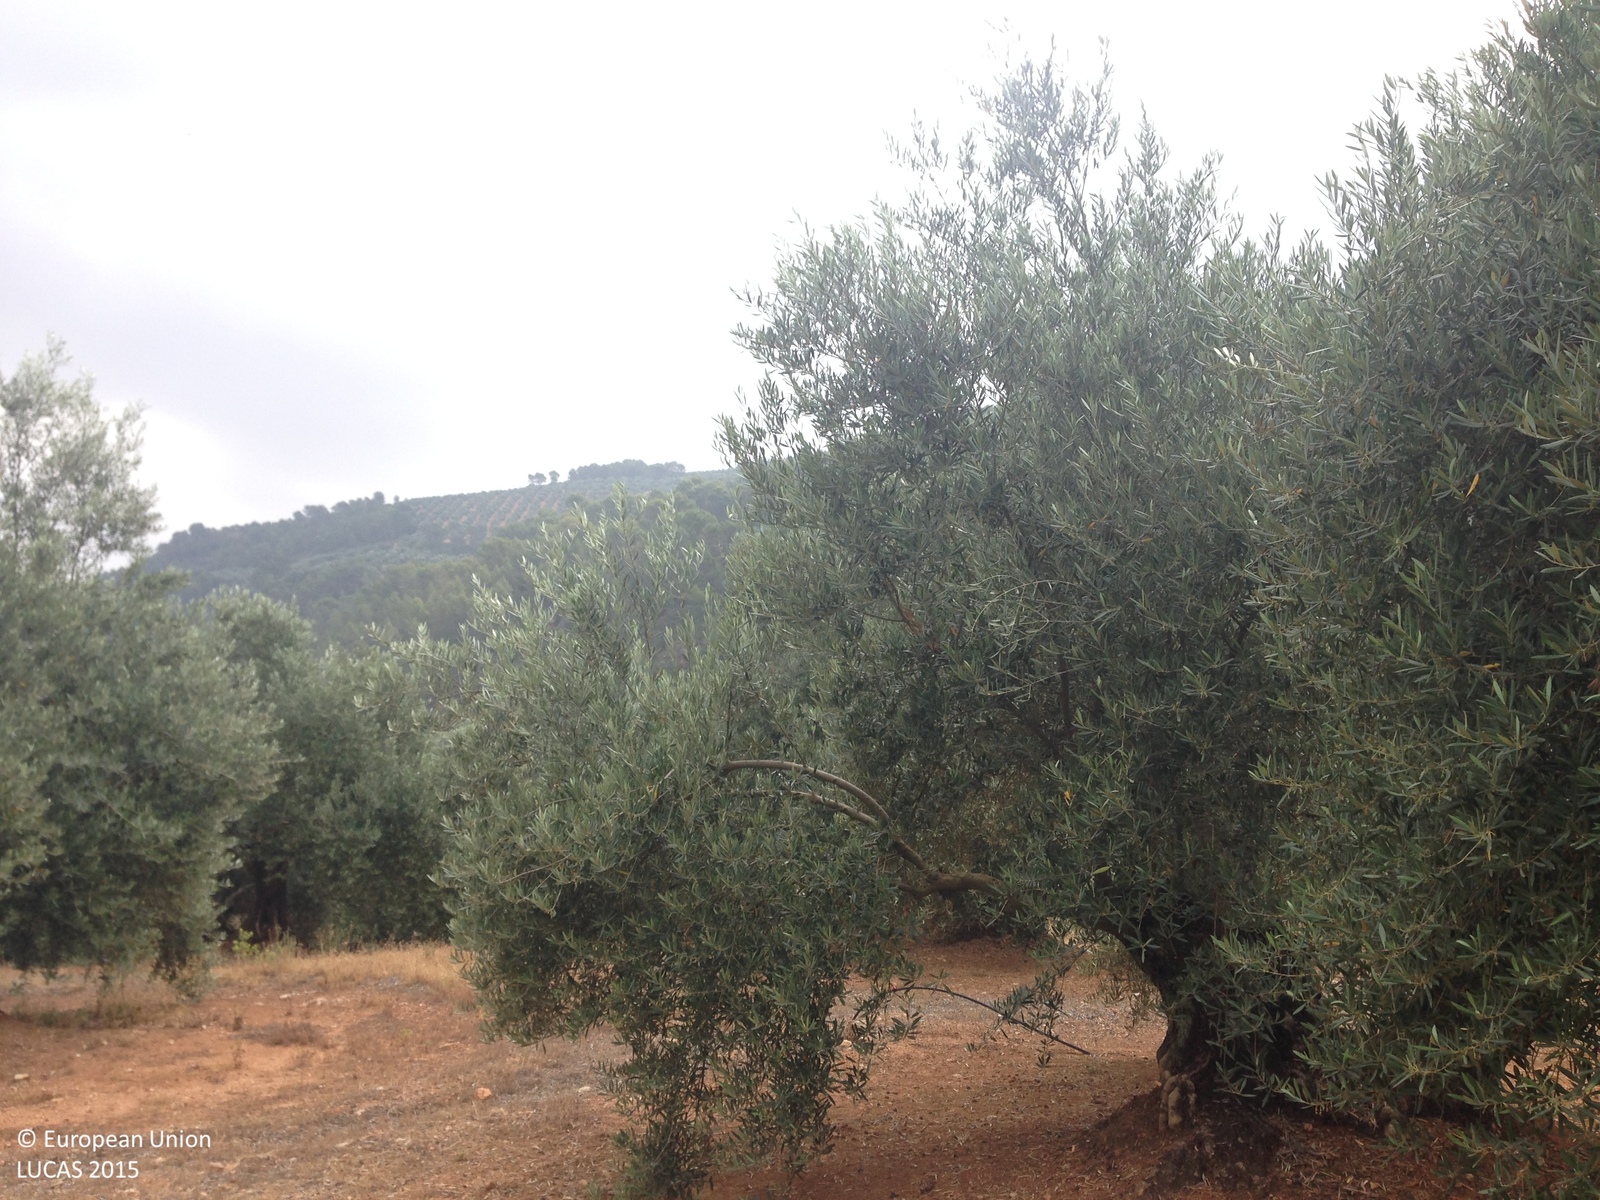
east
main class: Cropland
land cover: Olive groves
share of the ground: 25 - 50 %
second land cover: Other bare soil
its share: > 75 %
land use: Agriculture (excluding fallow land and kitchen gardens)
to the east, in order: Olive groves; Other bare soil; Tracks; Olive groves; Broadleaved woodland; Inland fresh running water; Shrubland with sparse tree cover; Tracks; Olive groves; Pine dominated mixed woodland; Olive groves; Pine dominated mixed woodland
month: June
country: ES
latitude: 38.1596
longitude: -2.9517
